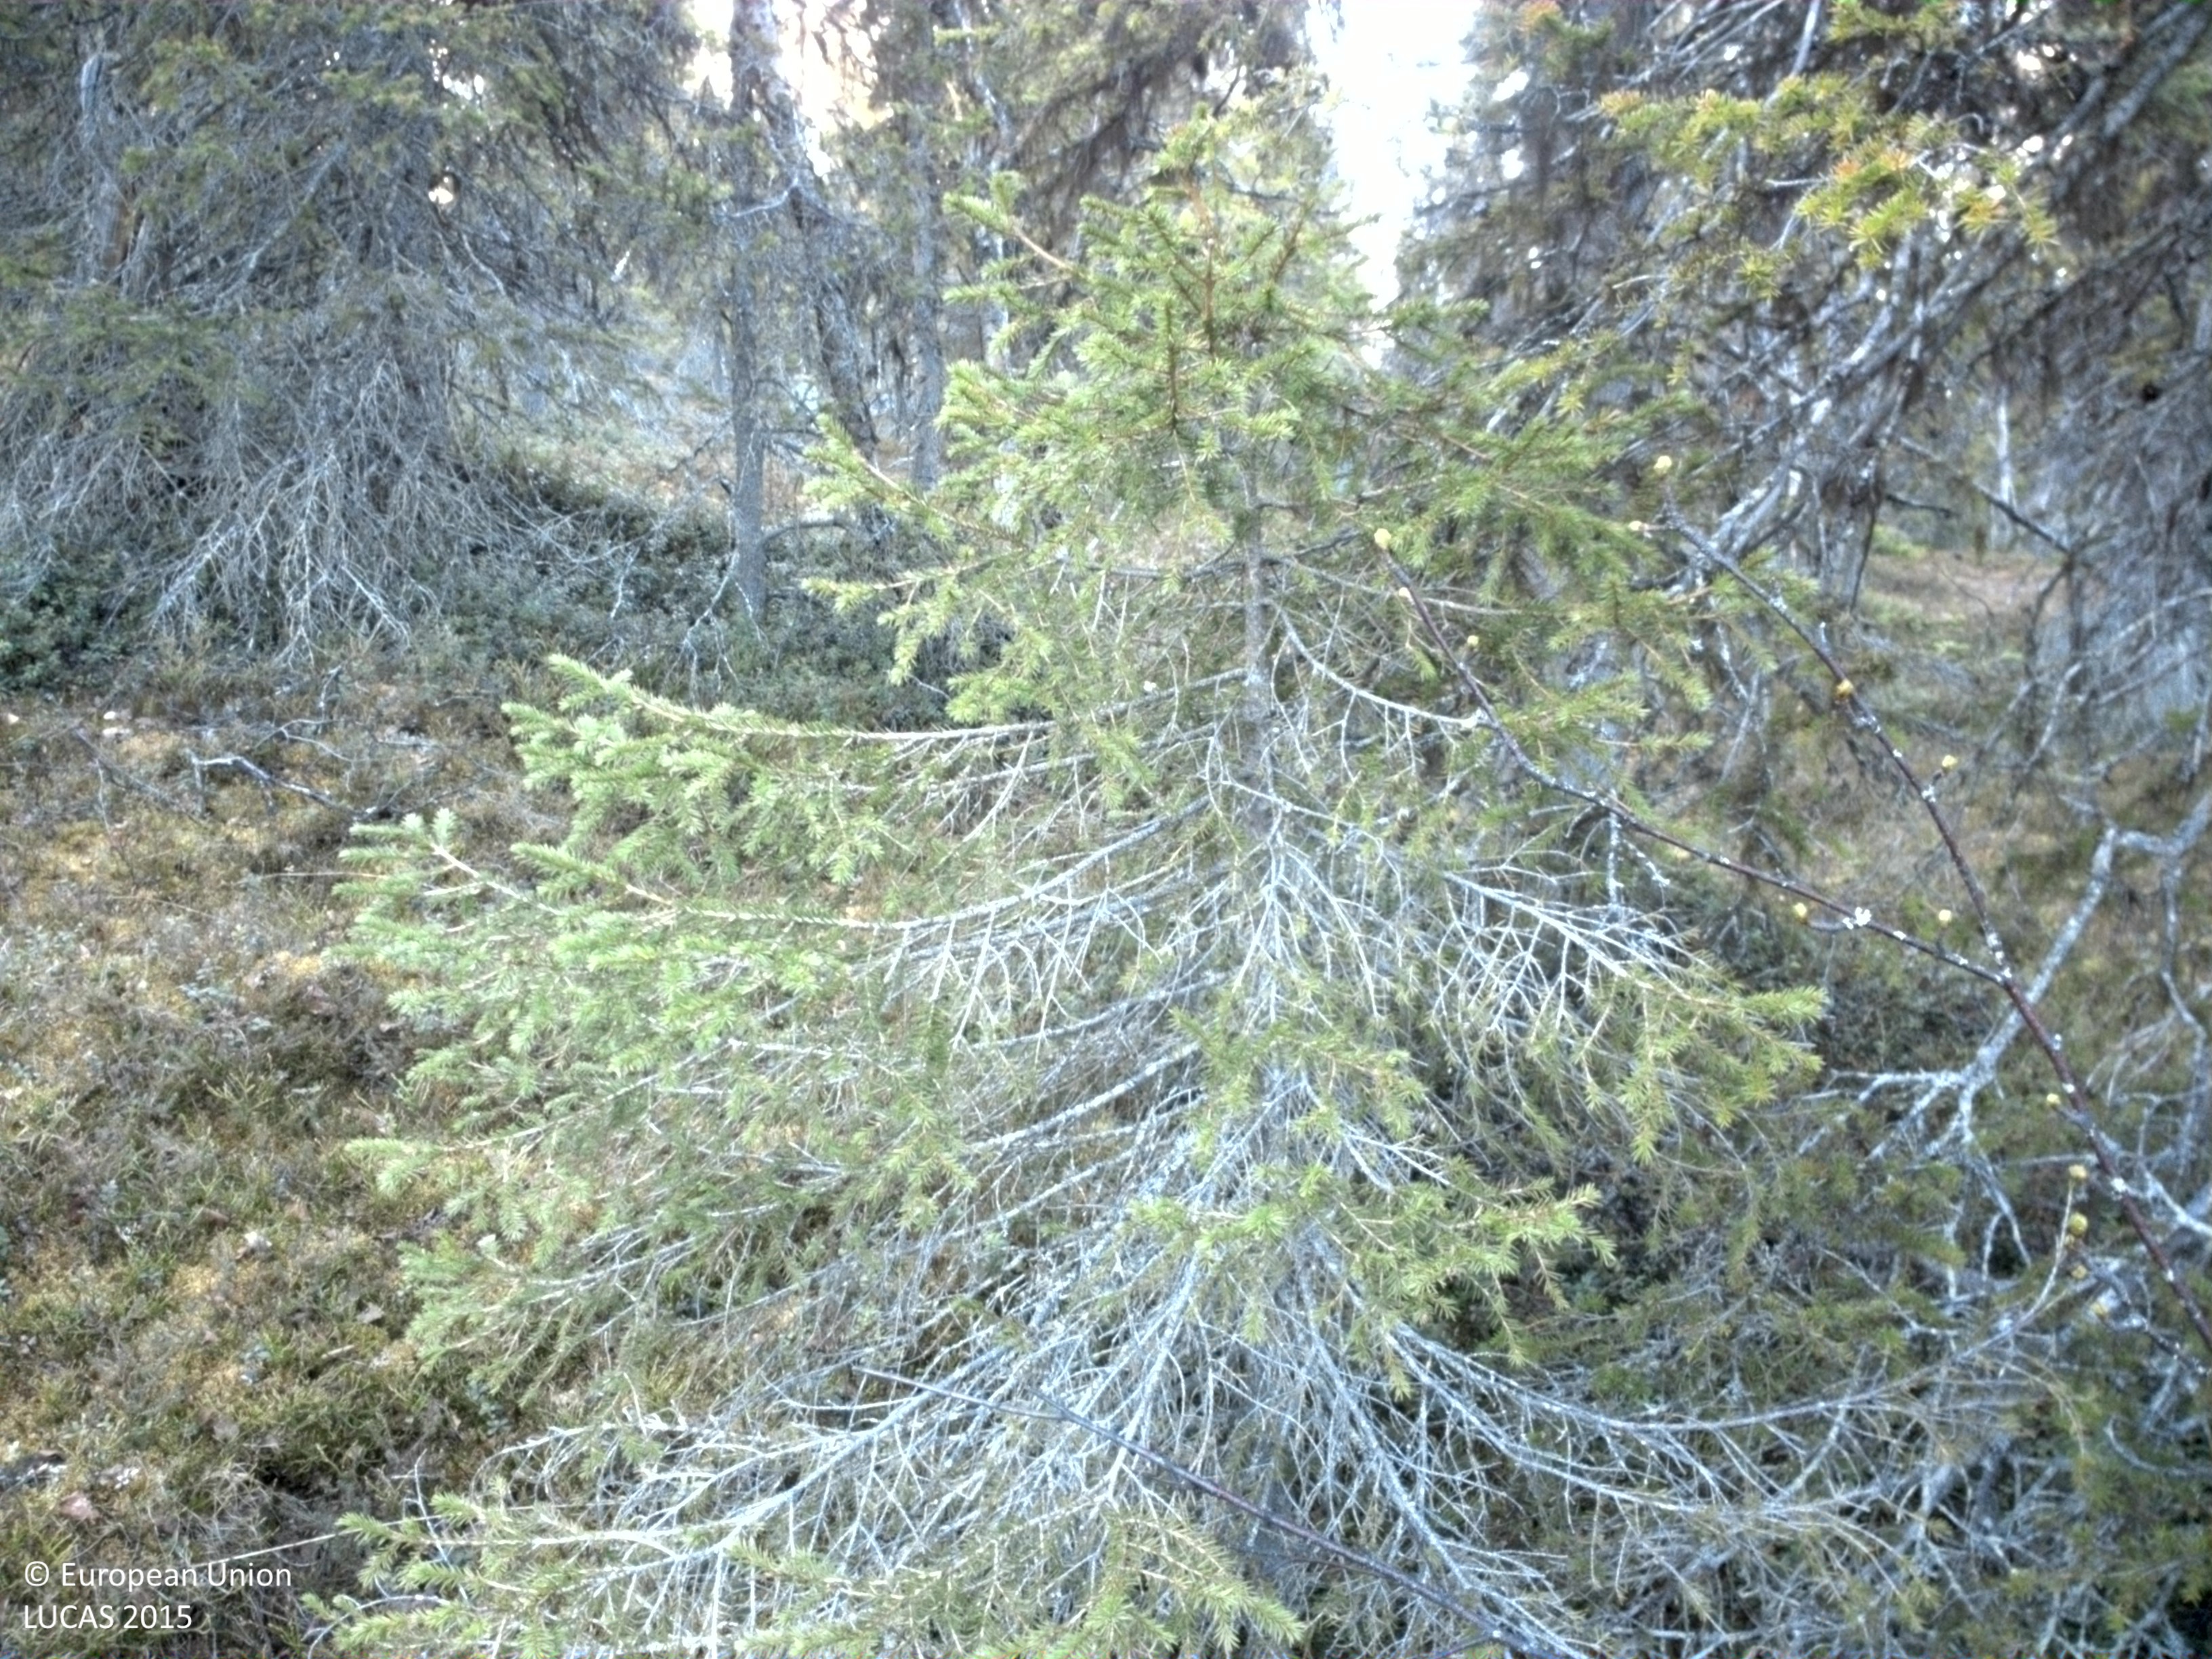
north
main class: Woodland
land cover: Spruce dominated mixed woodland
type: boreal forest
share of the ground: 50 - 75 %
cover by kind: coniferous forest trees 50 %, shrubs 30 %, broadleaved forest trees 20 %
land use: Forestry
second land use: Amenities, museums, leisure
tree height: > 5 m
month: June
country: SE
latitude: 67.2671
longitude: 20.1724
